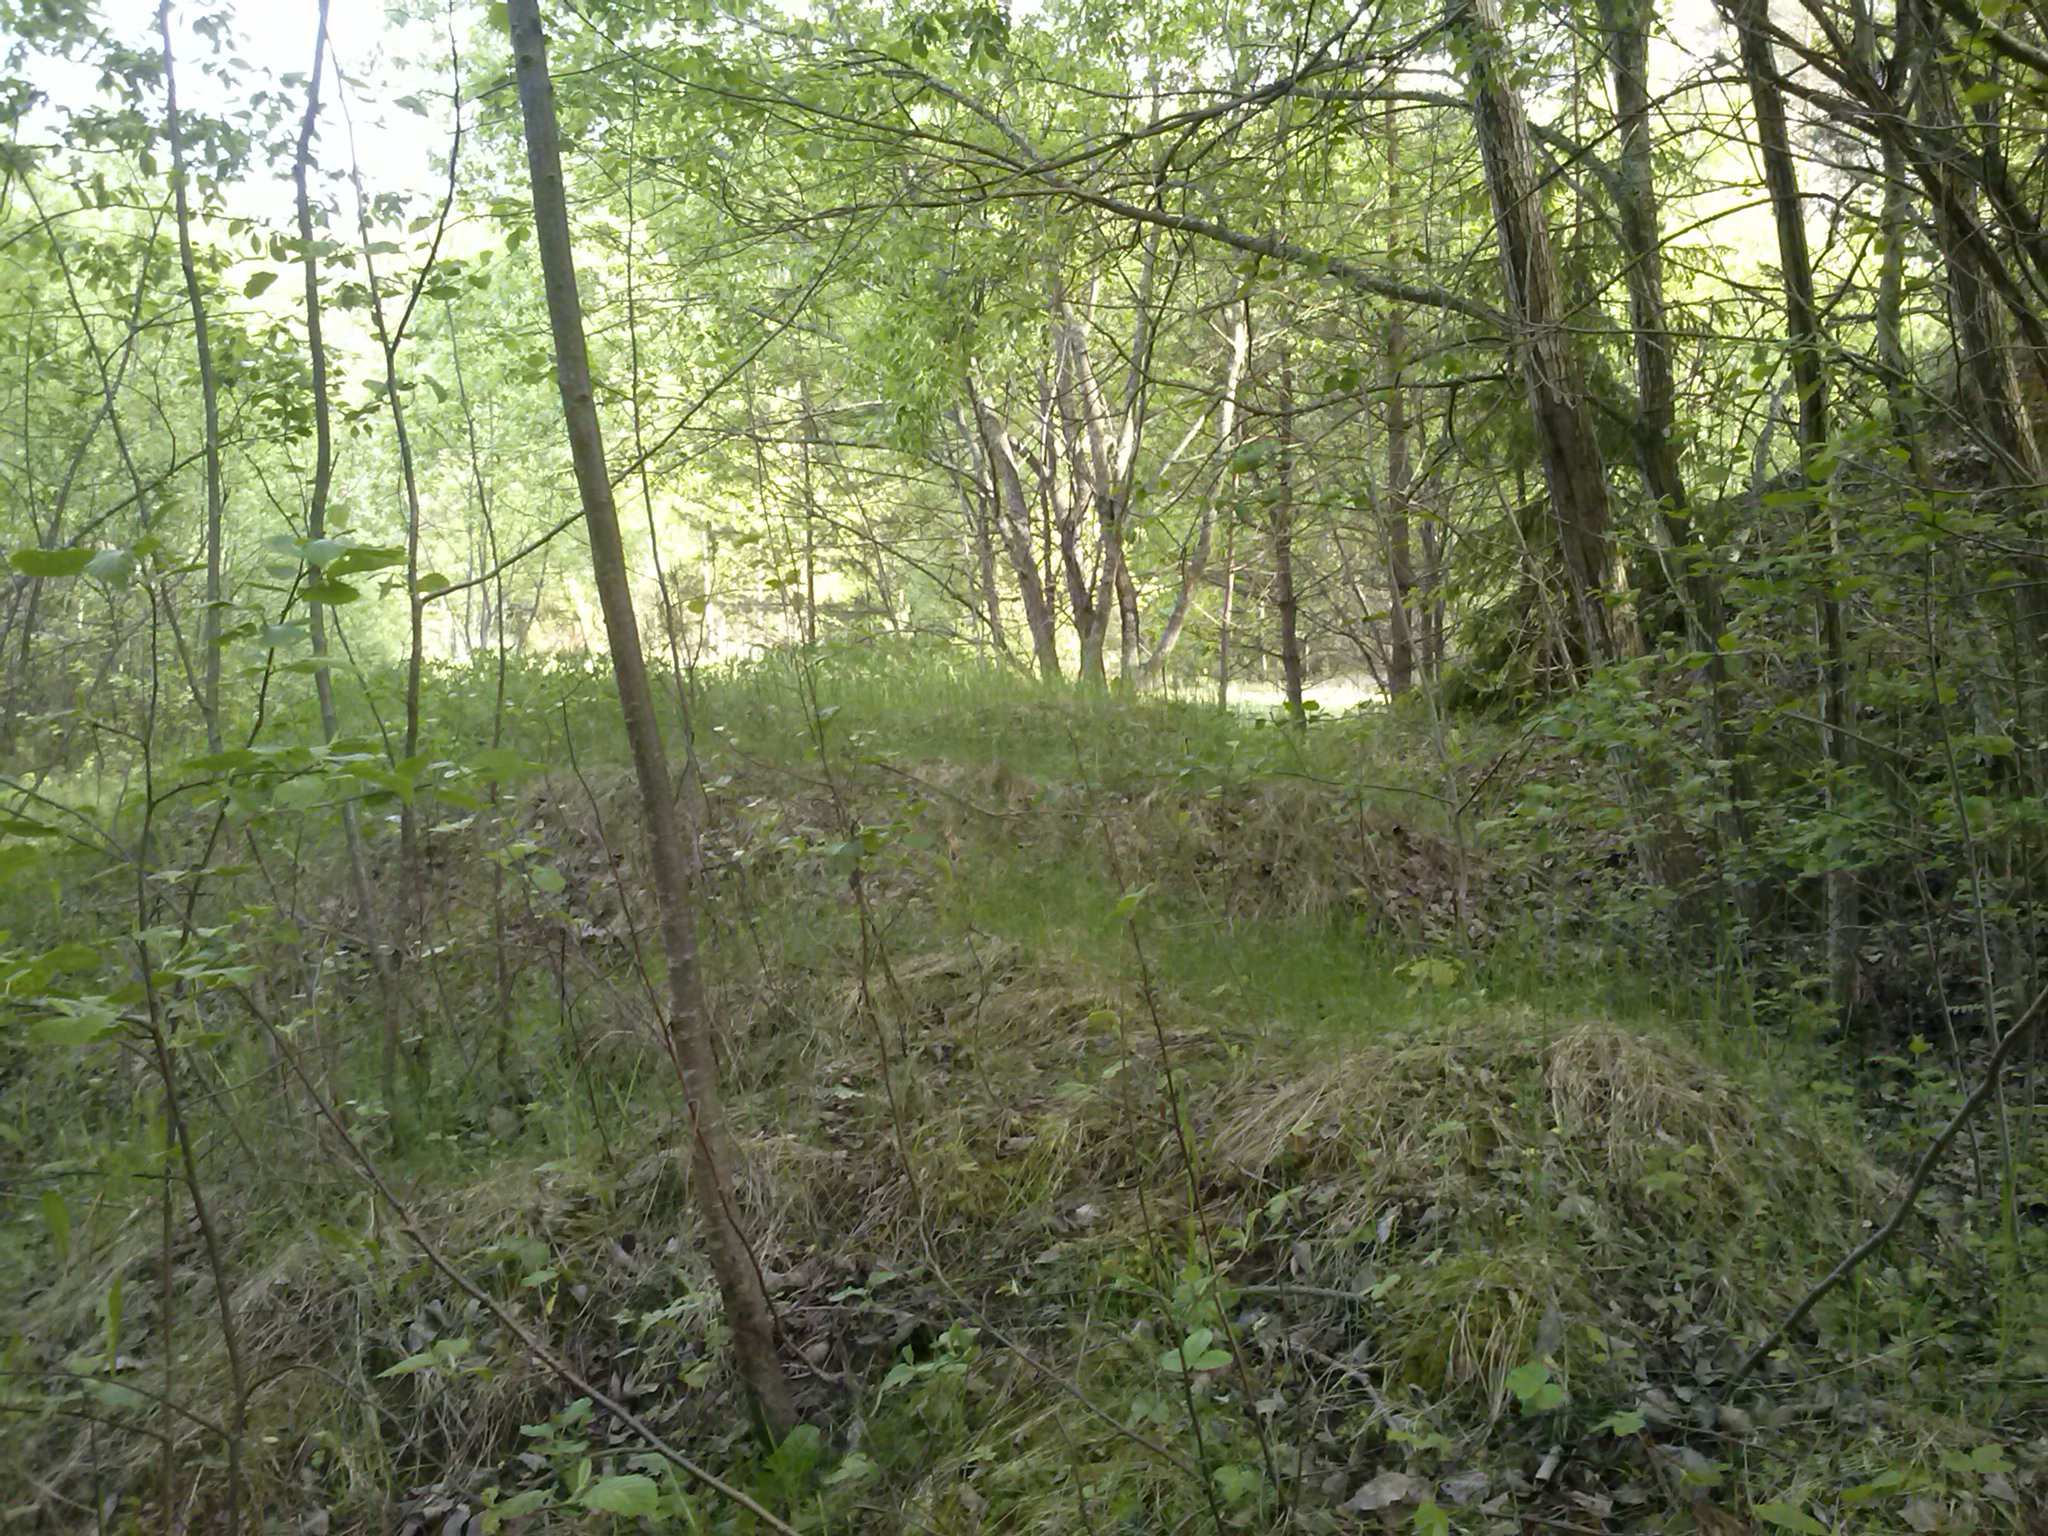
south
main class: Woodland
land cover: Broadleaved woodland
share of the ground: > 75 %
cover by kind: broadleaved forest trees 100 %
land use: Forestry
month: May
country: LV
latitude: 56.3137
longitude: 27.7950
